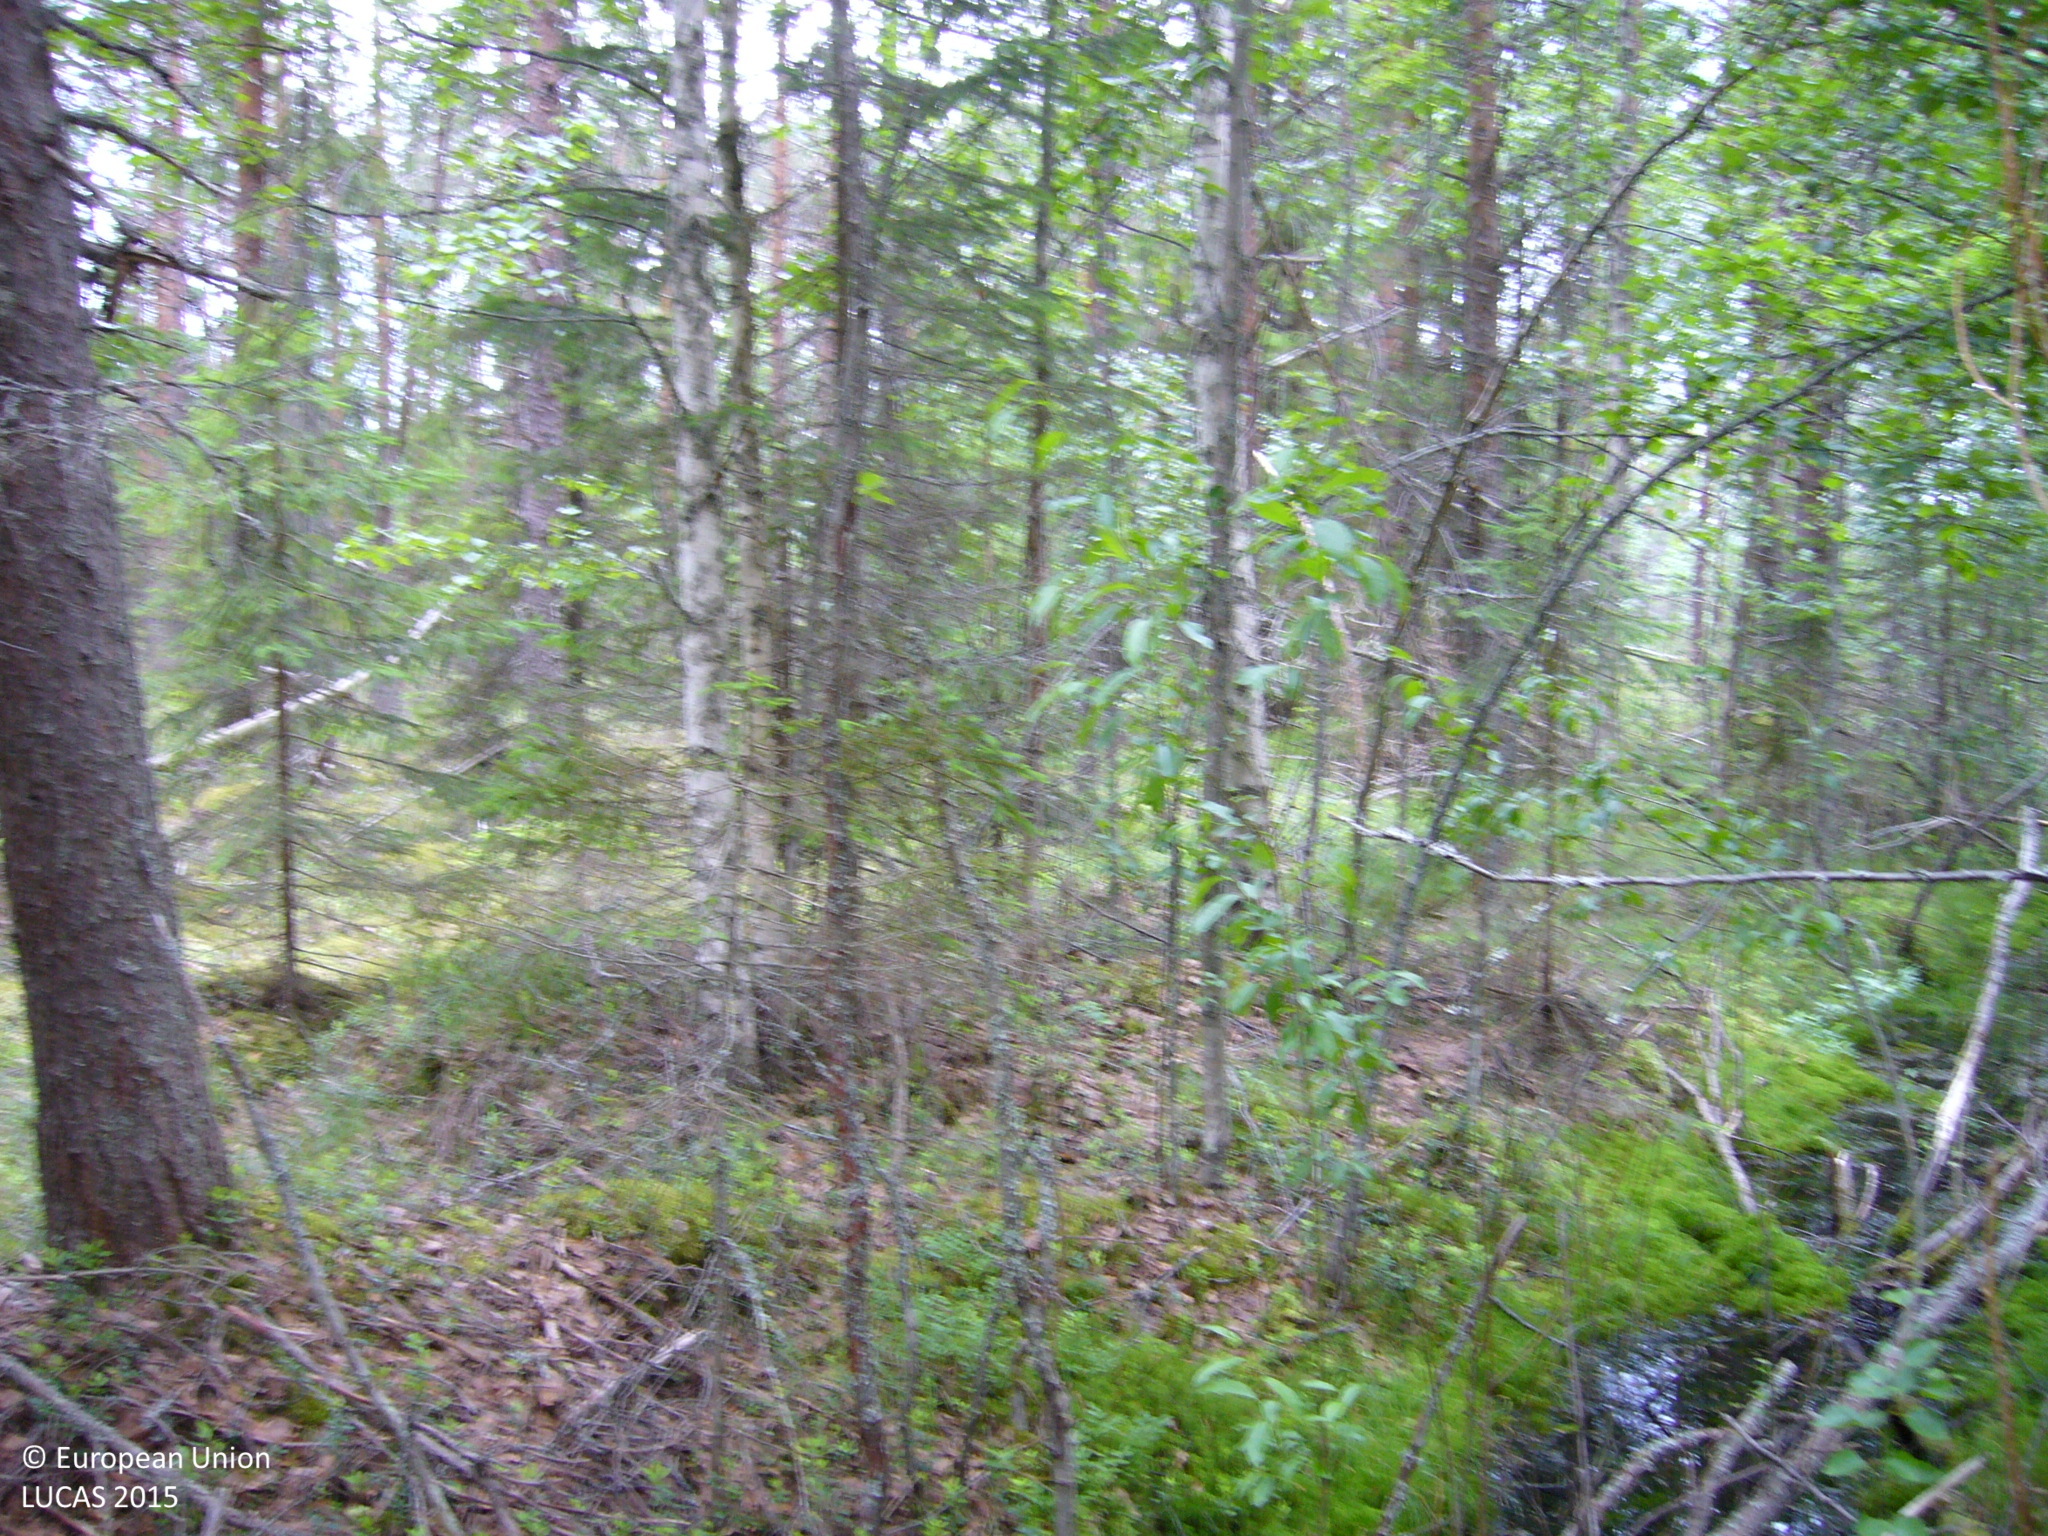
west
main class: Woodland
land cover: Other mixed woodland
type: boreal forest
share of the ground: > 75 %
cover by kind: coniferous forest trees 40 %, broadleaved forest trees 35 %, shrubs 25 %
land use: Forestry
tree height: > 5 m
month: July
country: FI
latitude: 63.2694
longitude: 26.1209
